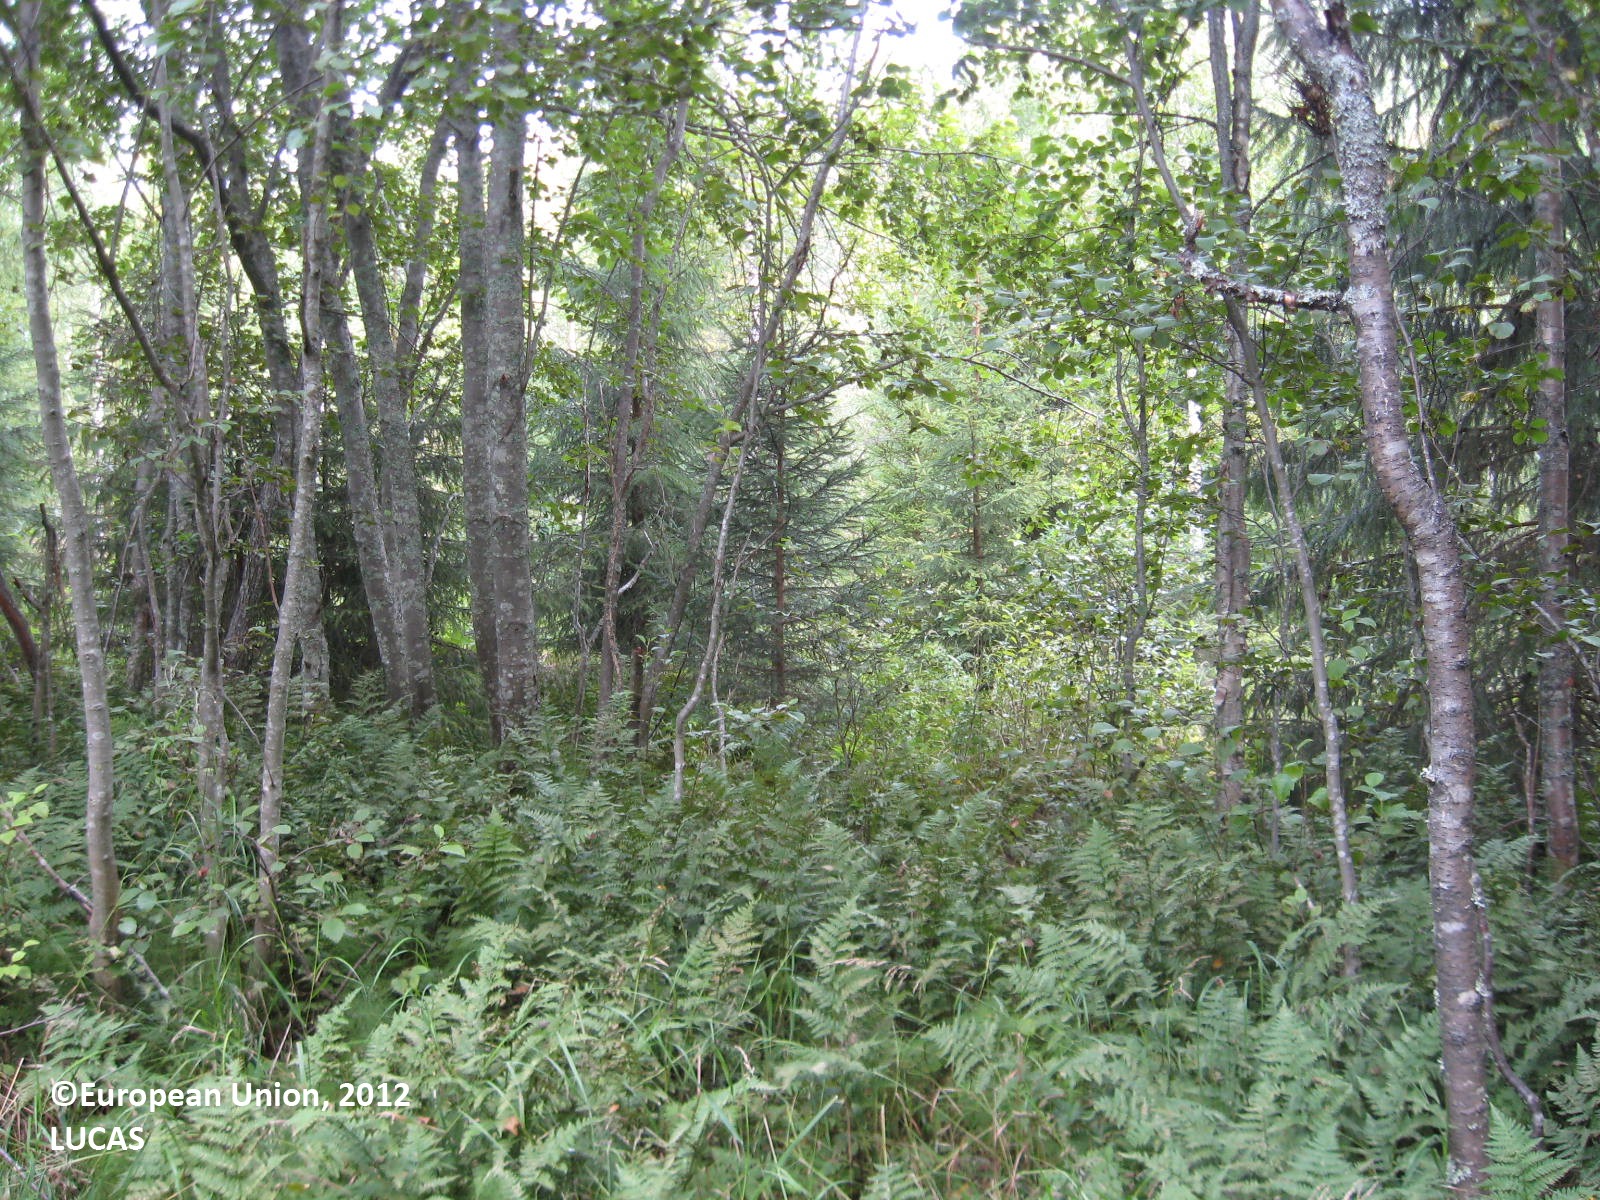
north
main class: Woodland
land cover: Broadleaved woodland
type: boreal forest
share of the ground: 50 - 75 %
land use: Forestry
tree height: > 5 m
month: August
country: FI
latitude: 63.4168
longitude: 29.6010
